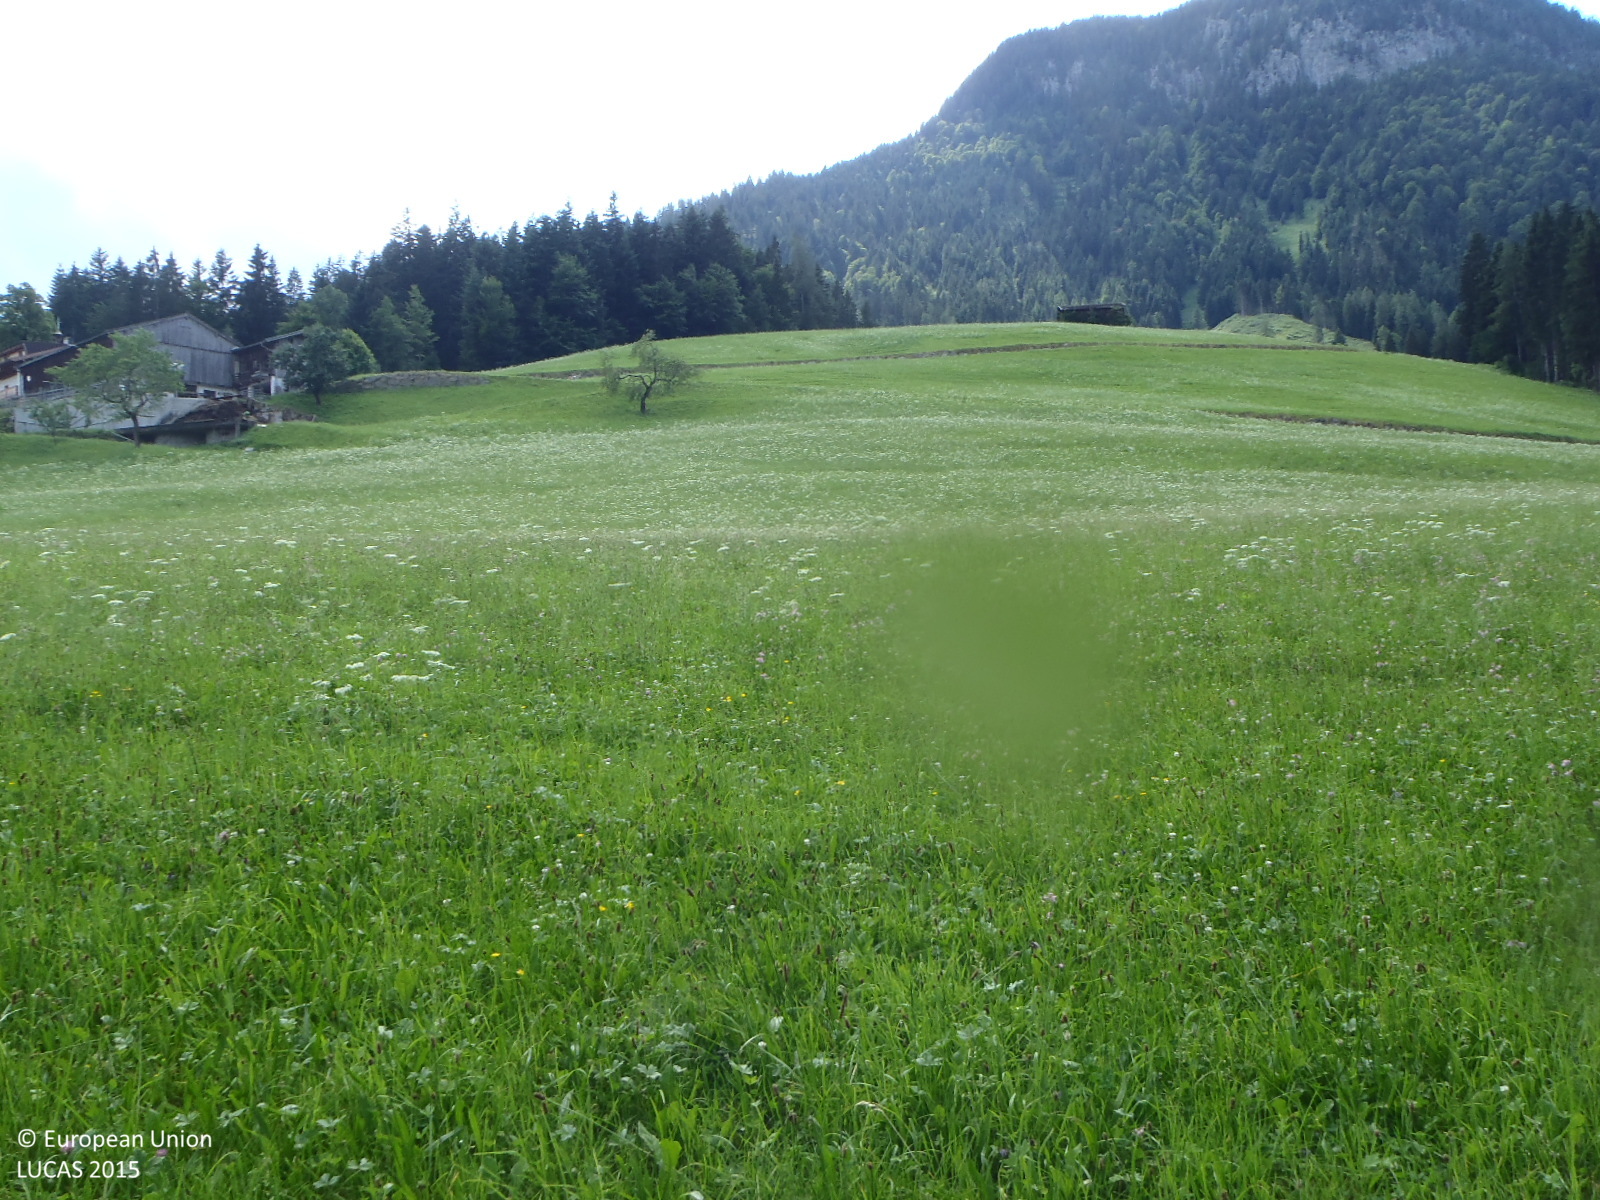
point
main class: Grassland
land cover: Grassland without tree/shrub cover
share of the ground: > 75 %
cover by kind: herbaceous plants 100 %
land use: Agriculture (excluding fallow land and kitchen gardens)
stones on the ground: < 10 %
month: July
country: AT
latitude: 47.5177
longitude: 12.1896
